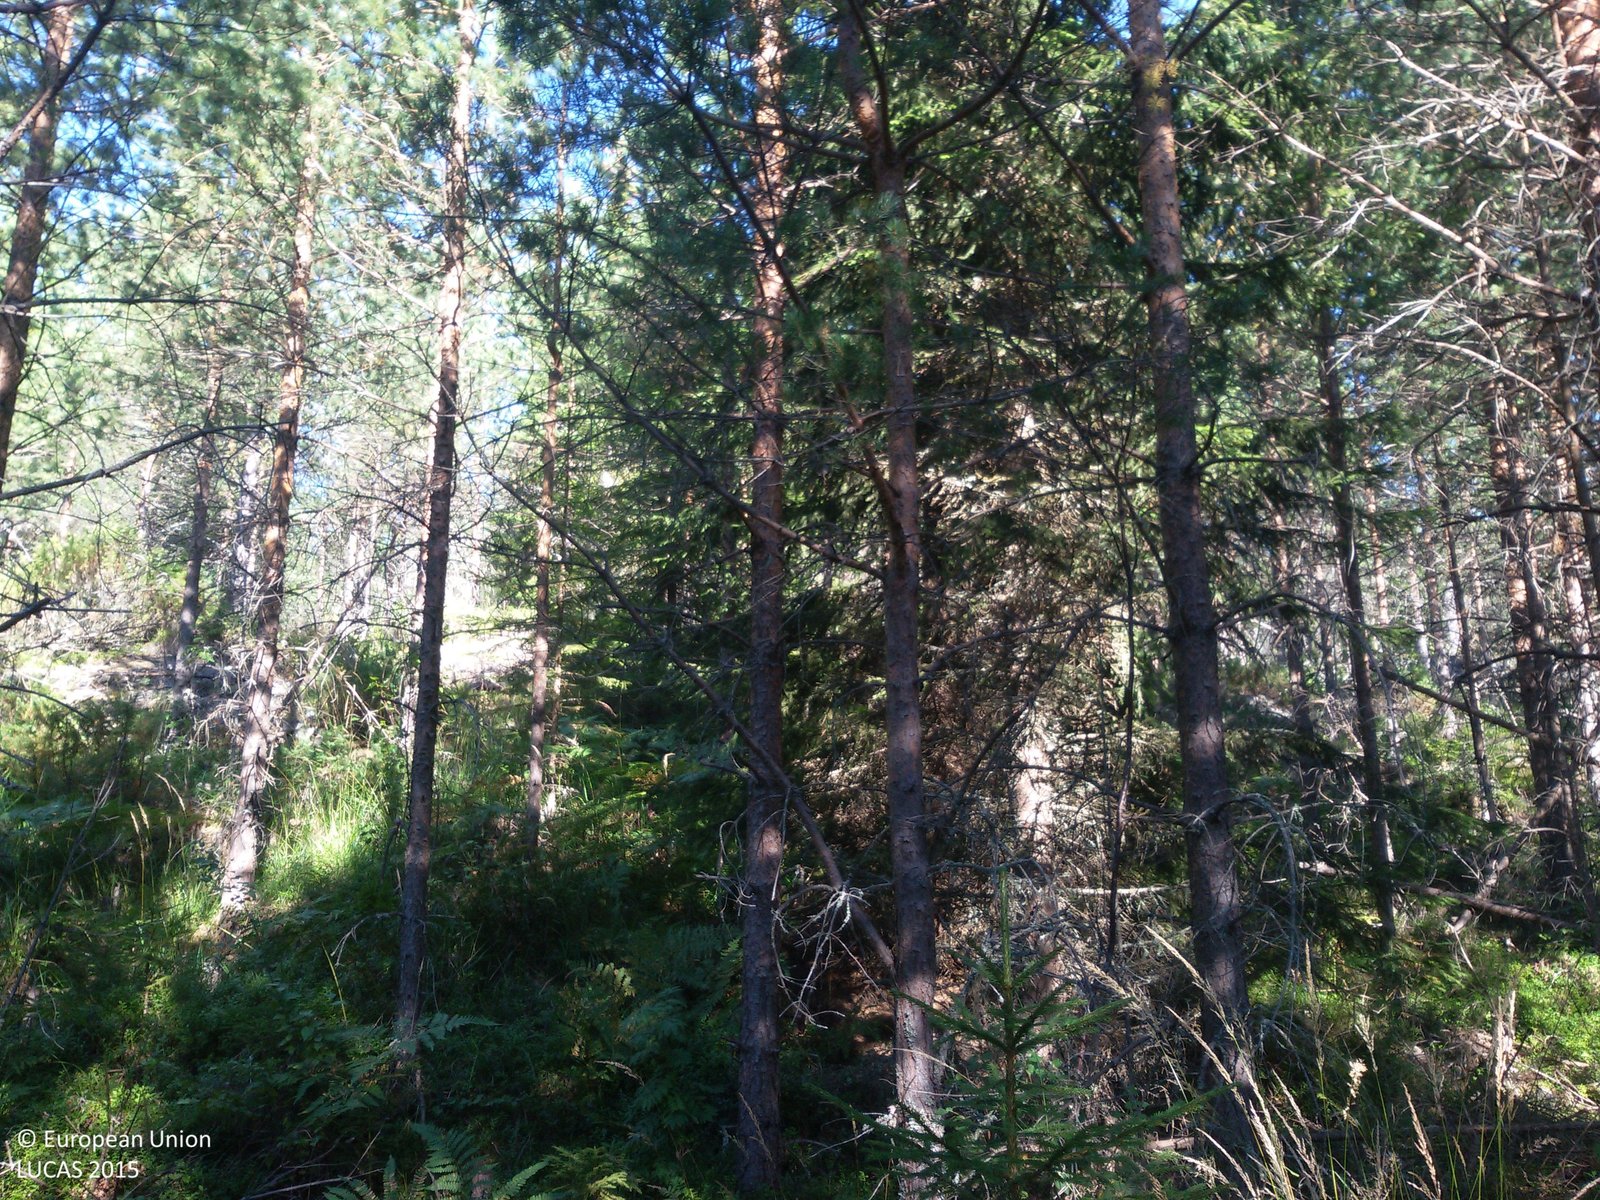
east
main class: Woodland
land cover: Pine dominated coniferous woodland
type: boreal forest
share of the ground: > 75 %
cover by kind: coniferous forest trees 80 %, shrubs 10 %, herbaceous plants 10 %
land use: Forestry
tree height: > 5 m
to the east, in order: Pine dominated coniferous woodland; Tracks; Pine dominated coniferous woodland; Spruce dominated coniferous woodland
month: August
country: SE
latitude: 60.6534
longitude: 15.8956
